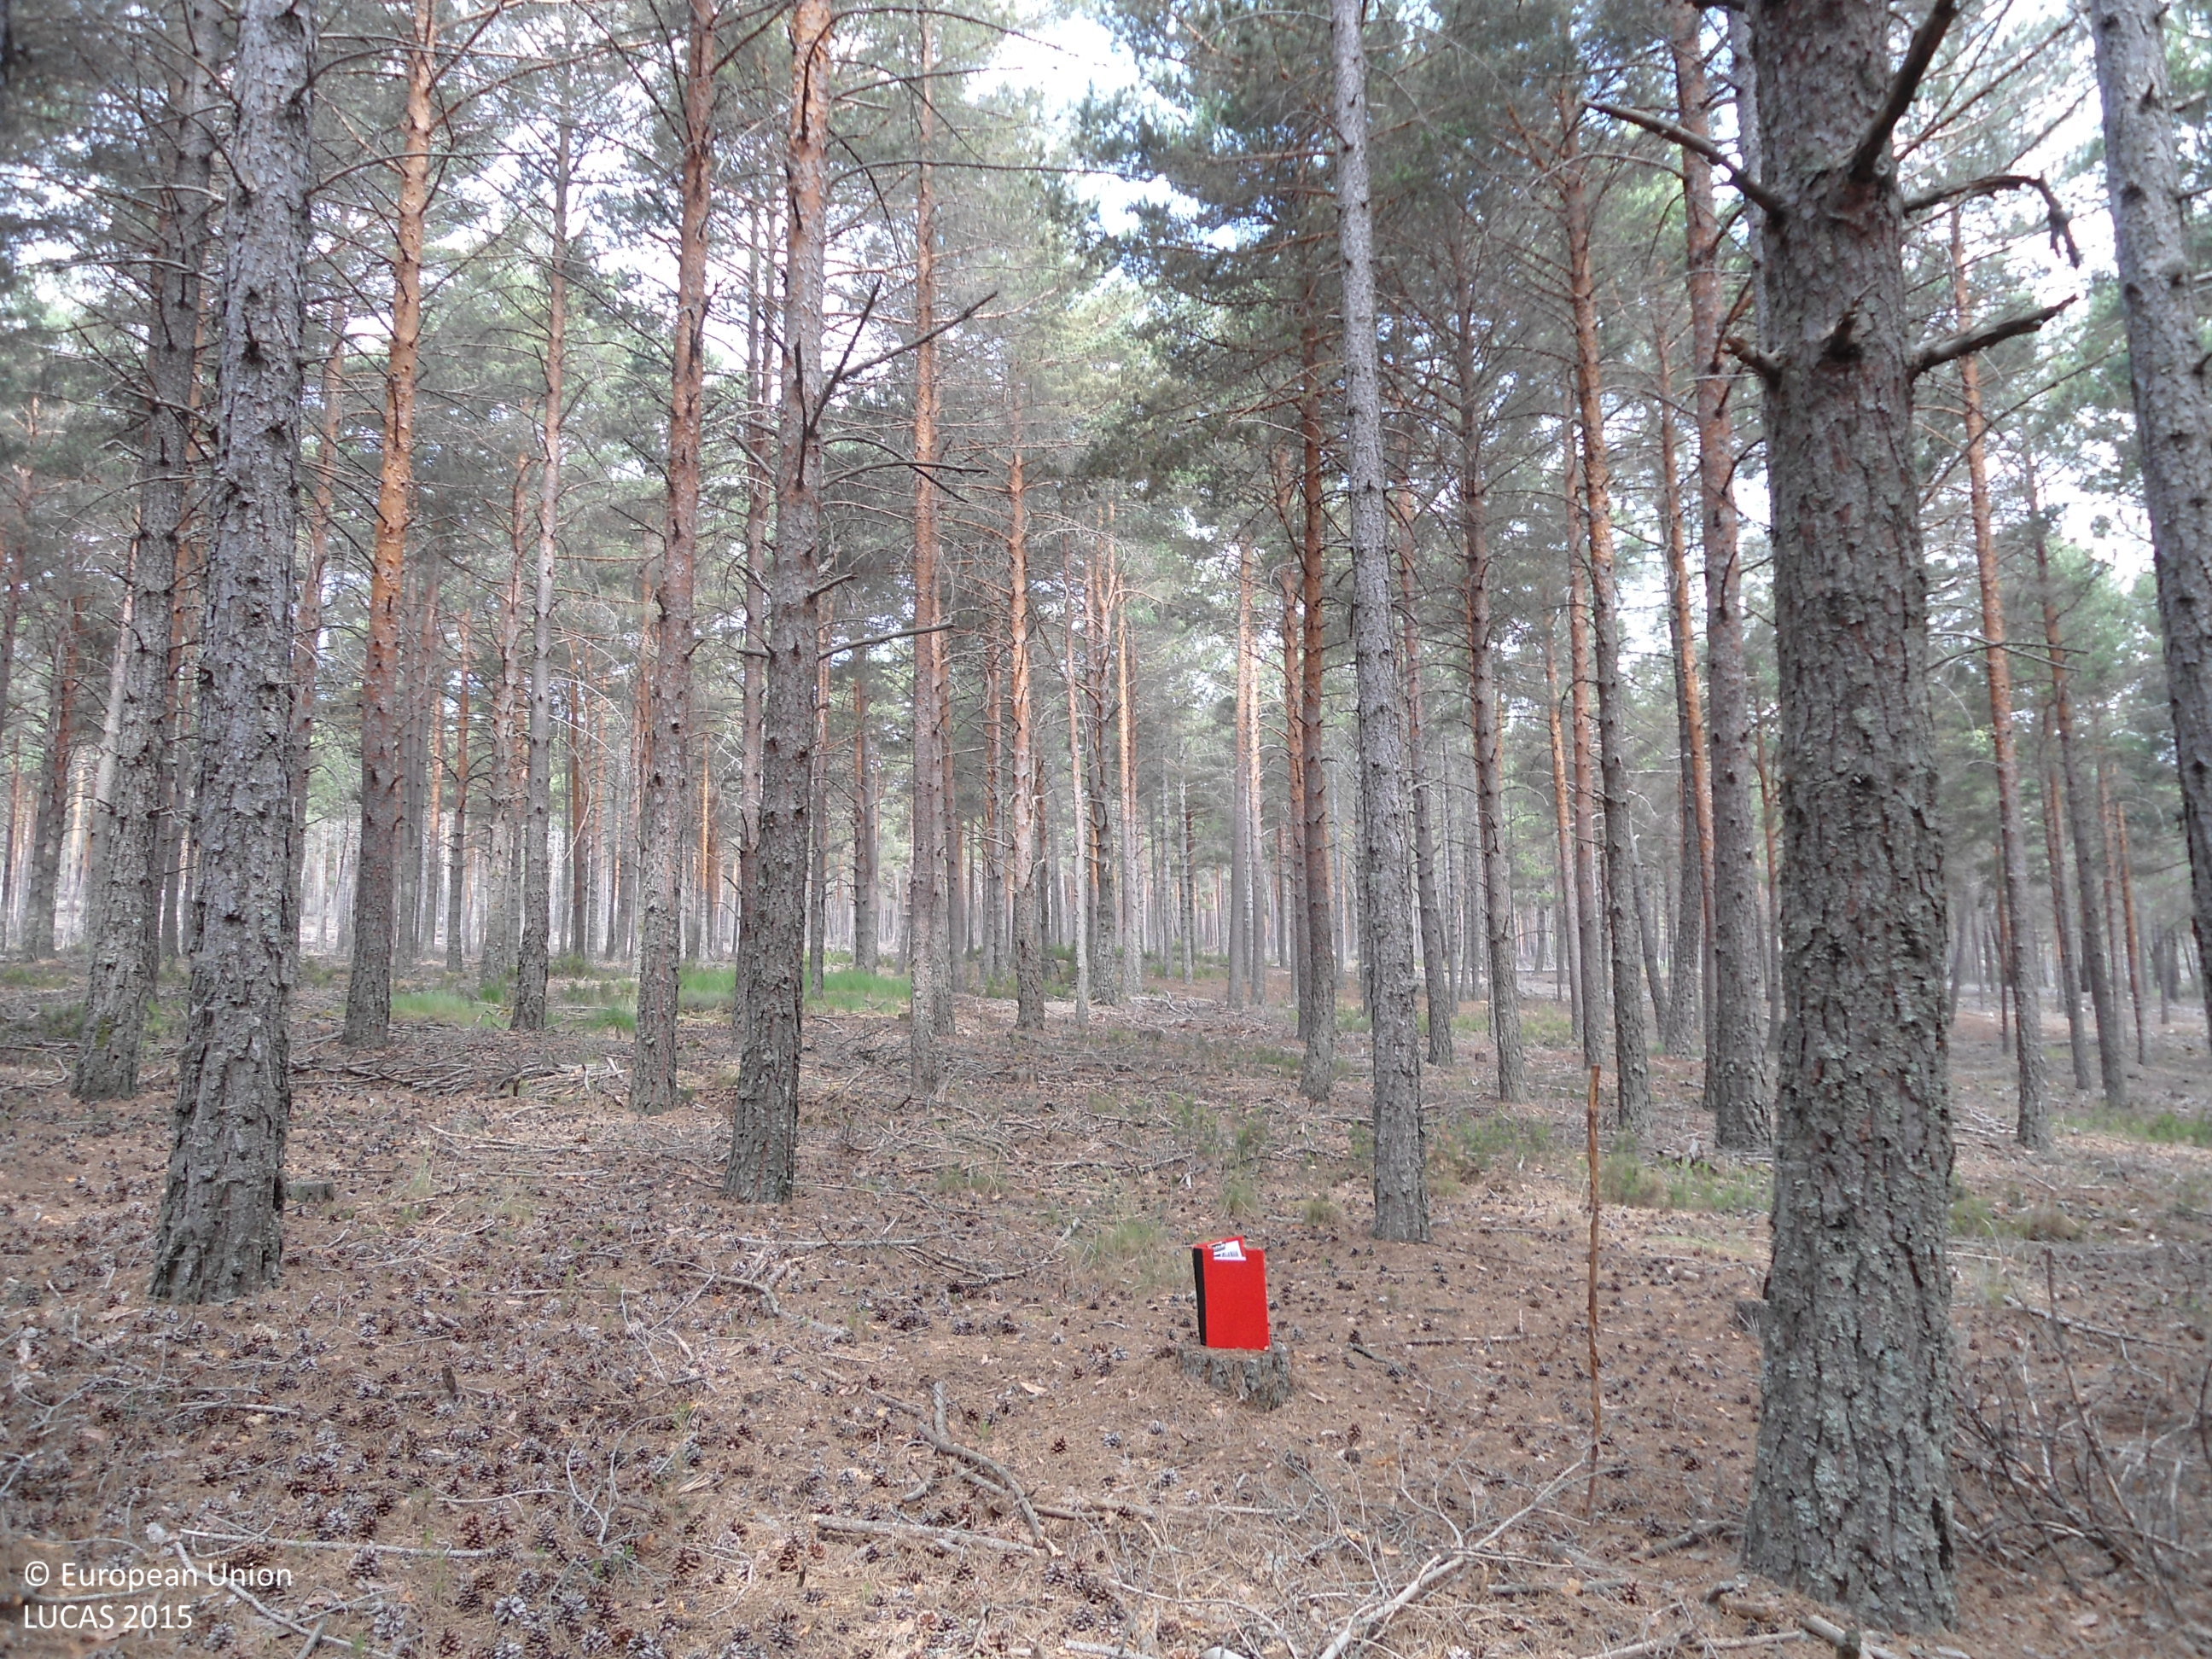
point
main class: Woodland
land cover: Pine dominated coniferous woodland
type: coniferous forest of the mediterranean region
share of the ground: > 75 %
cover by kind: coniferous forest trees 100 %
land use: Forestry
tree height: > 5 m
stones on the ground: < 10 %
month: June
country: ES
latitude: 41.9924
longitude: -6.5892
